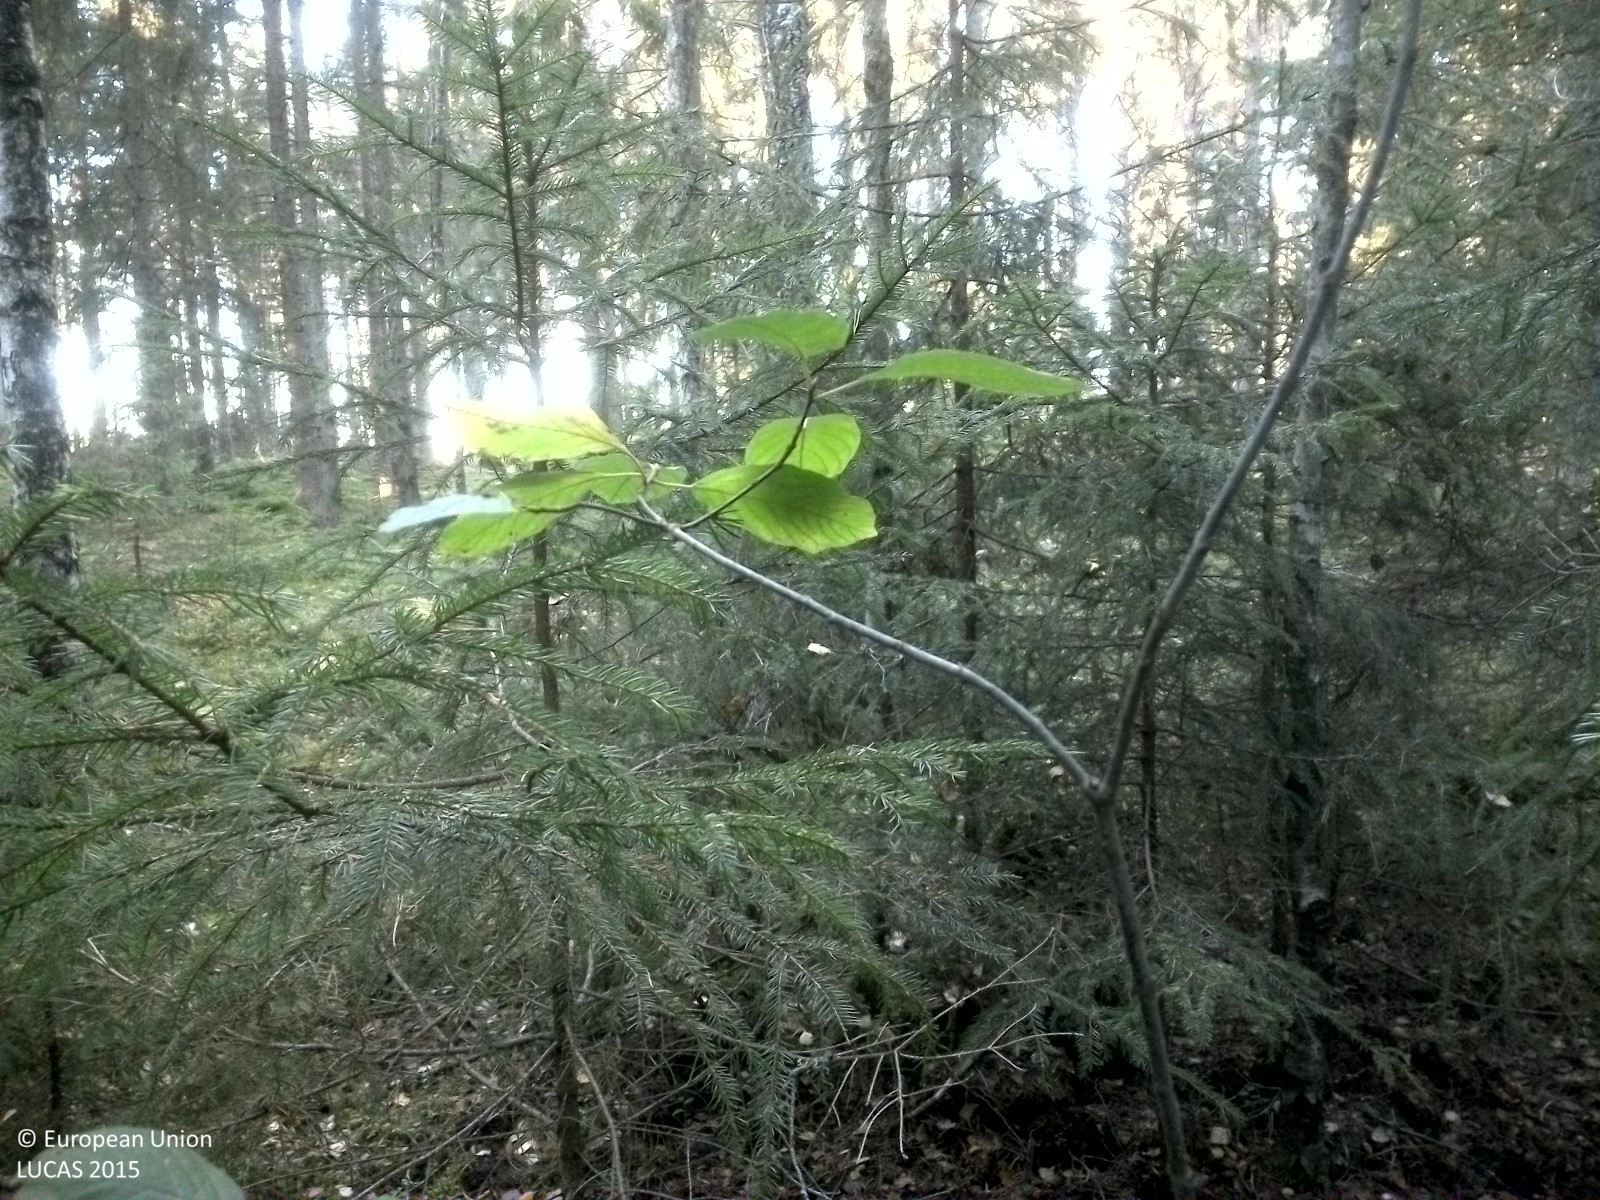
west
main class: Woodland
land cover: Spruce dominated mixed woodland
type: boreal forest
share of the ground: 50 - 75 %
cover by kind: coniferous forest trees 35 %, herbaceous plants 25 %, broadleaved forest trees 20 %, lichens and mosses 20 %
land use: Forestry
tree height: > 5 m
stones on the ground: < 10 %
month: September
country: SE
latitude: 58.7183
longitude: 16.7472
